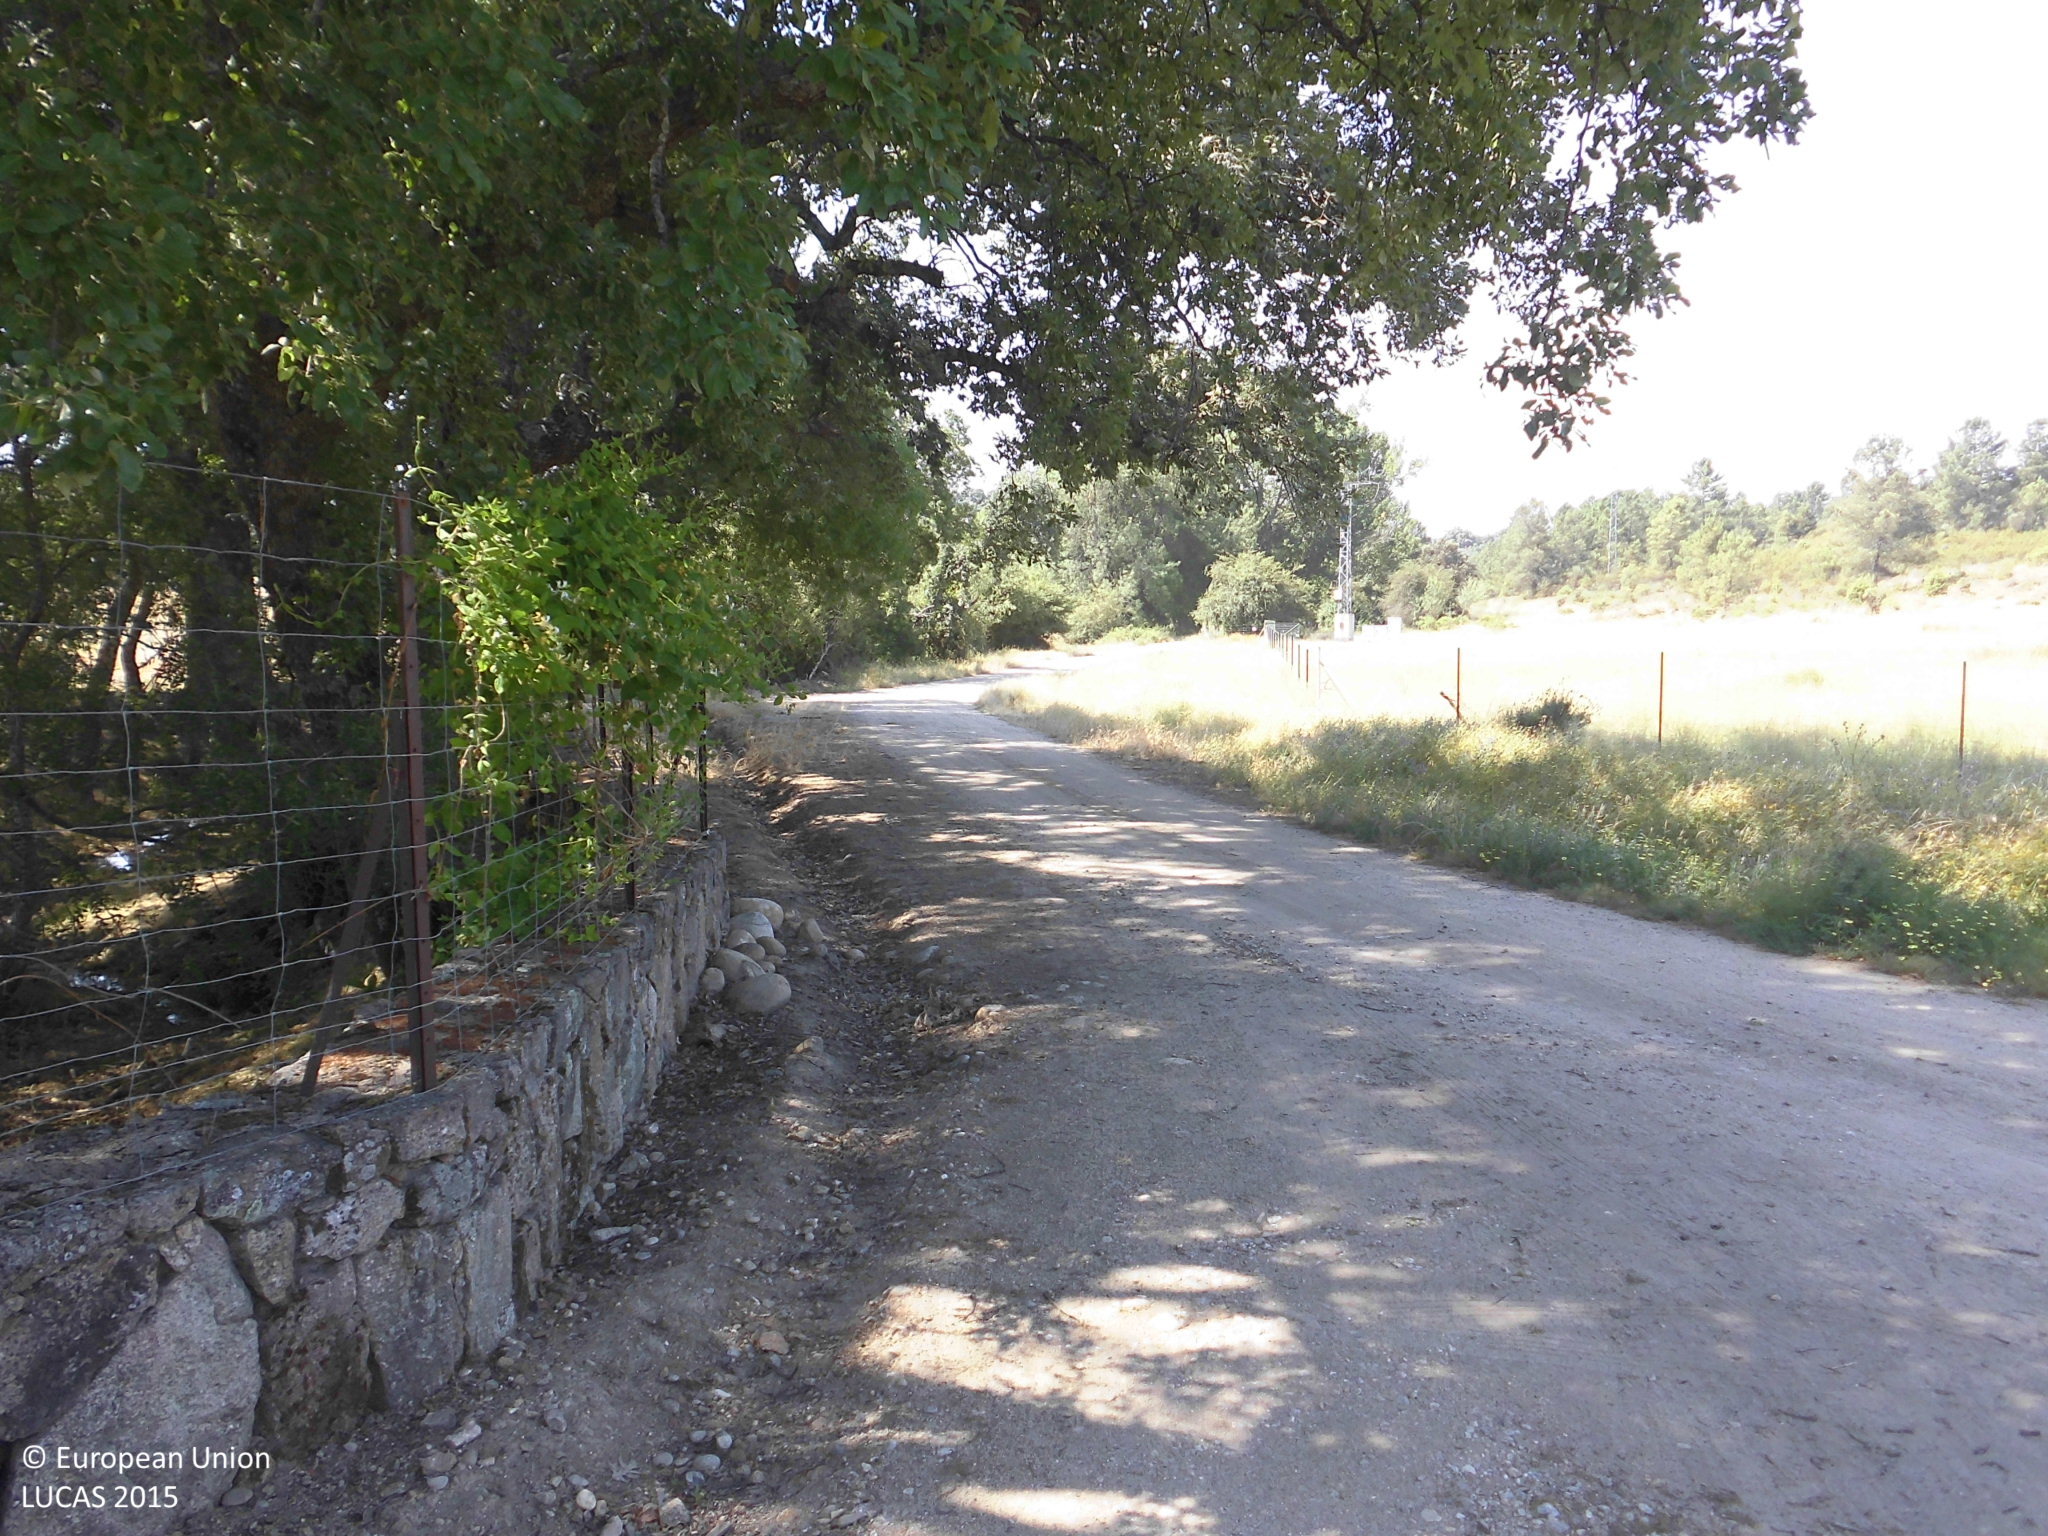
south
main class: Shrubland
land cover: Shrubland with sparse tree cover
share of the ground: 25 - 50 %
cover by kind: herbaceous plants 50 %, shrubs 45 %, broadleaved forest trees 5 %
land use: Agriculture (excluding fallow land and kitchen gardens)
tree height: > 5 m
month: June
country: ES
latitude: 40.1029
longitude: -5.4395
